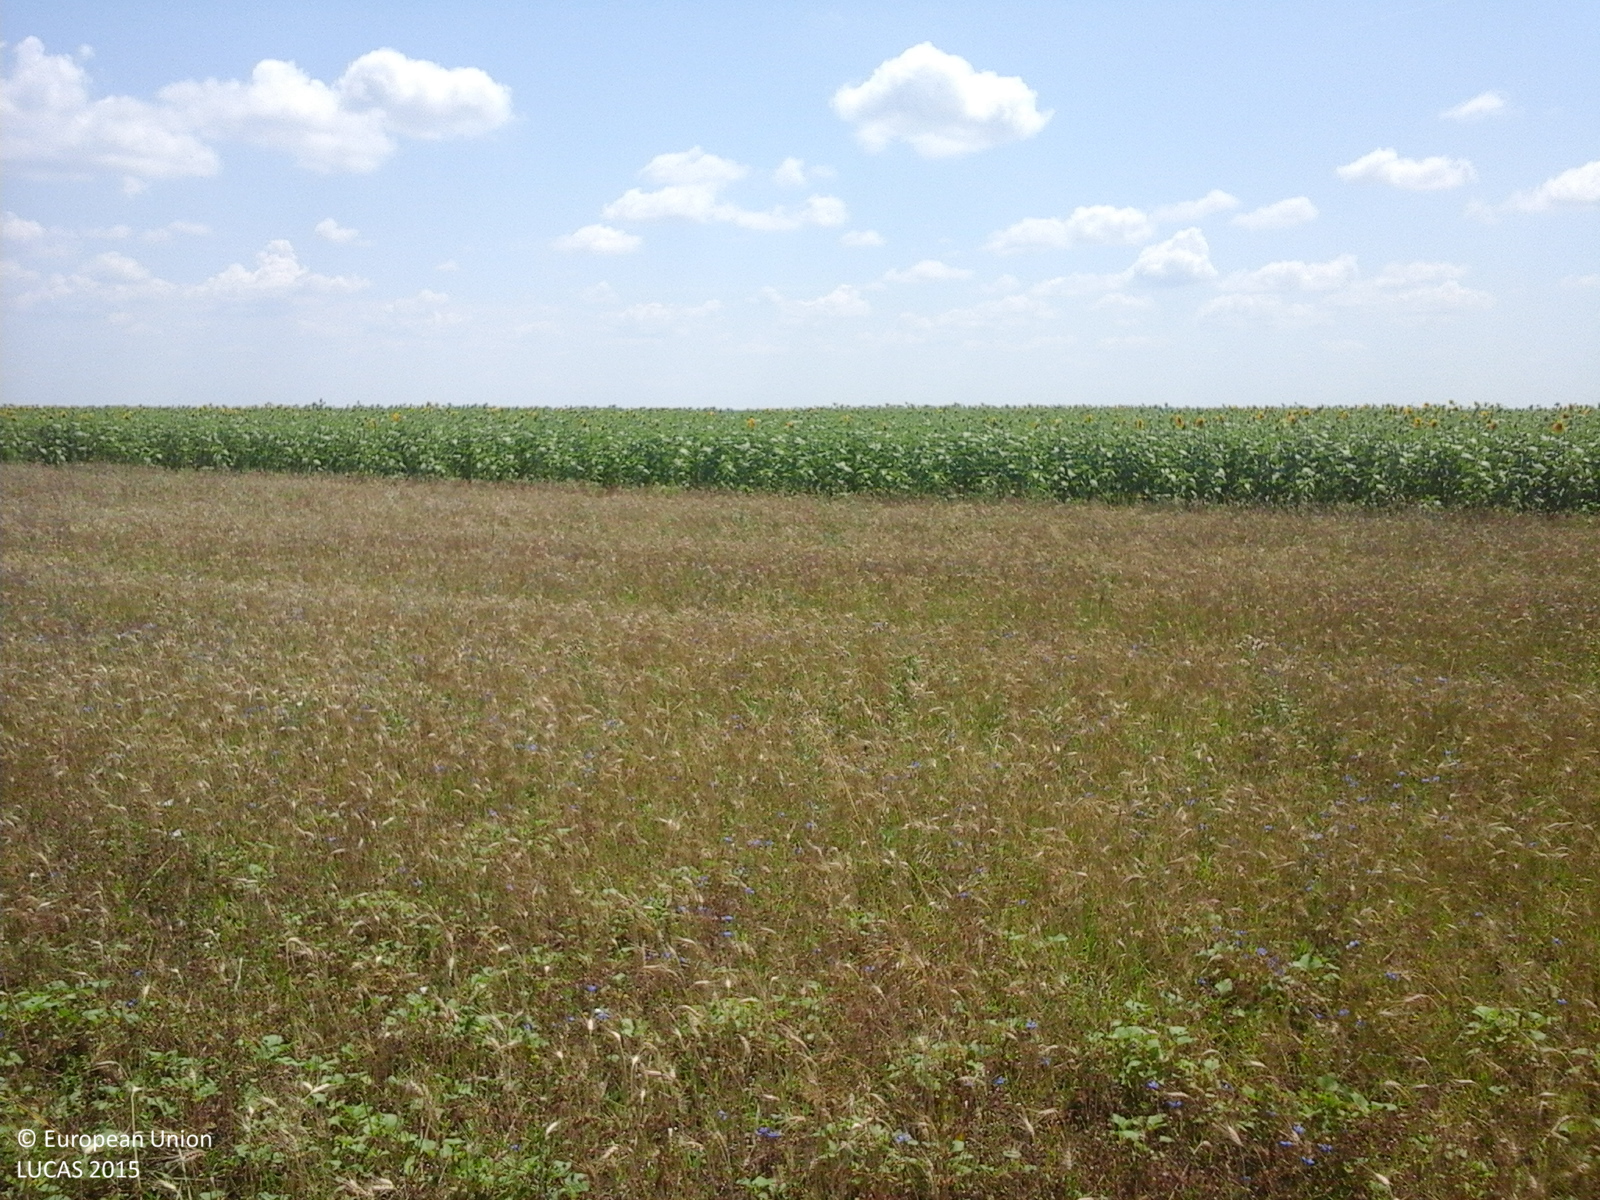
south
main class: Cropland
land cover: Sunflower
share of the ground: 25 - 50 %
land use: Agriculture (excluding fallow land and kitchen gardens)
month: July
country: RO
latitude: 44.1970
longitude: 24.2909
